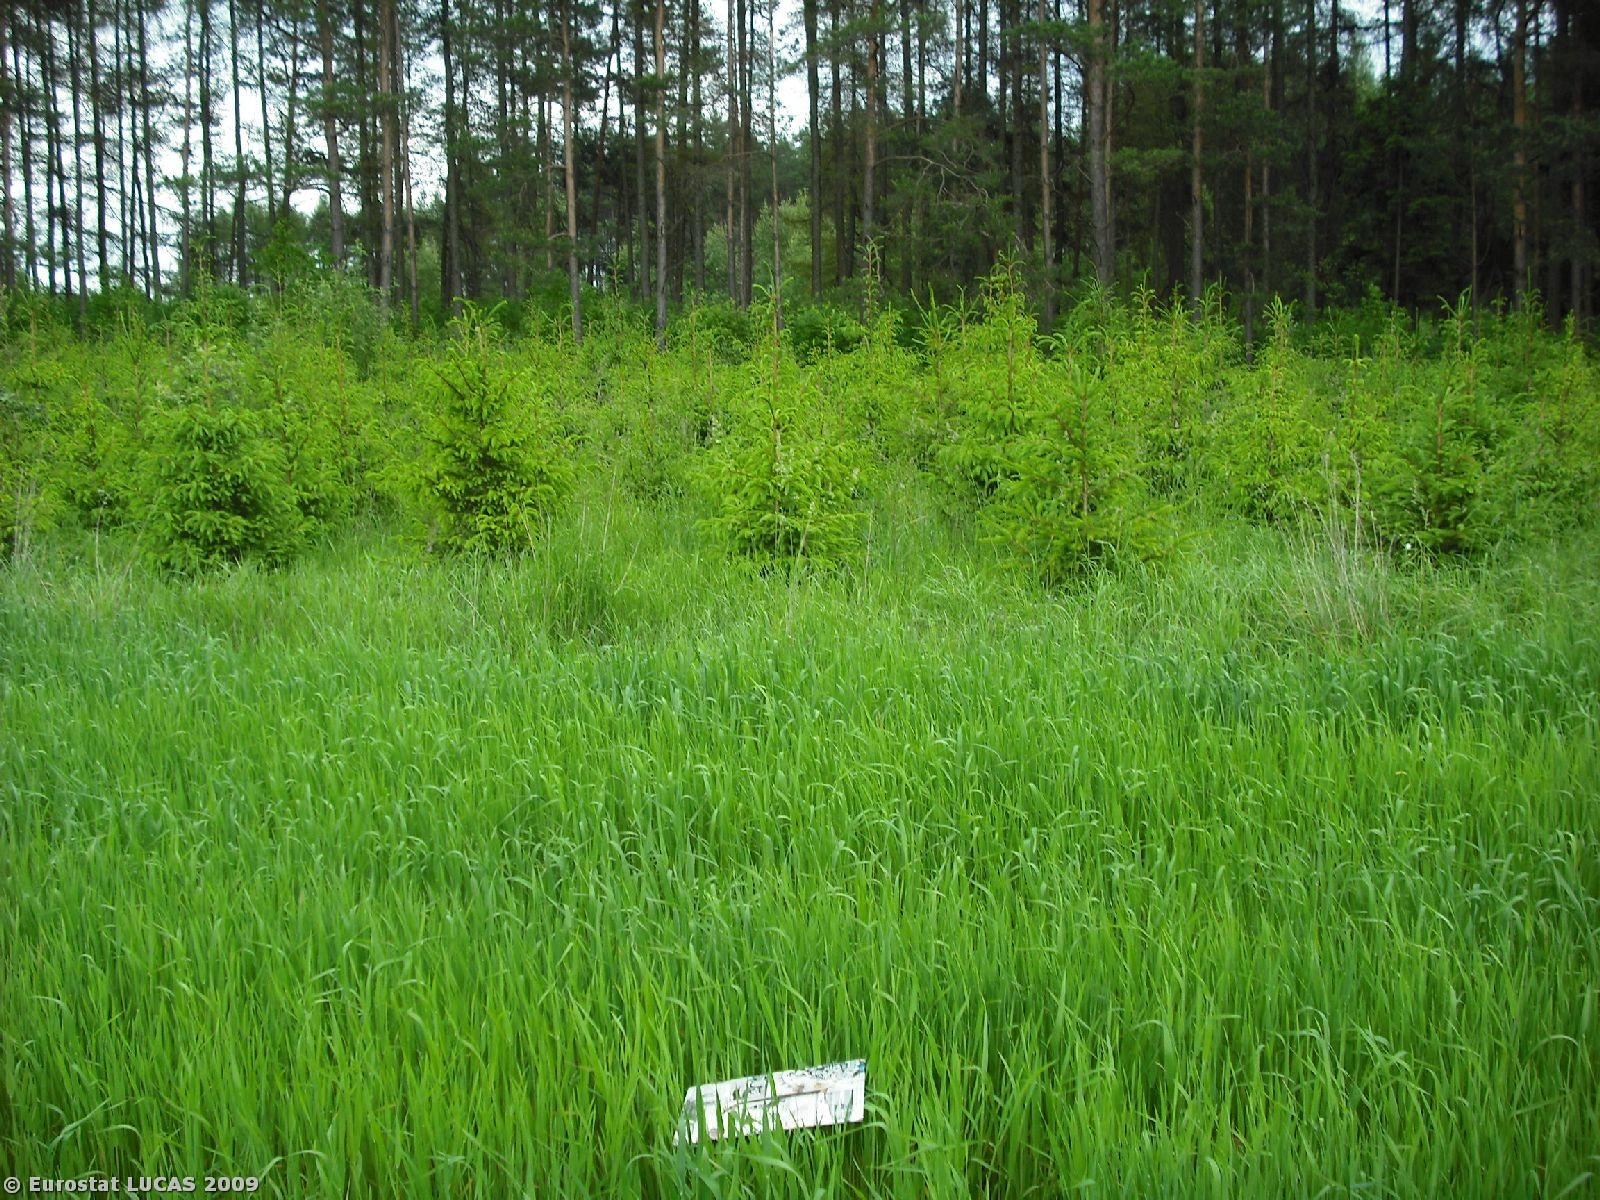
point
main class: Cropland
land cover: Oats
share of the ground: > 75 %
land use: Agriculture (excluding fallow land and kitchen gardens)
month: June
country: PL
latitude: 54.1732
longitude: 22.8311
